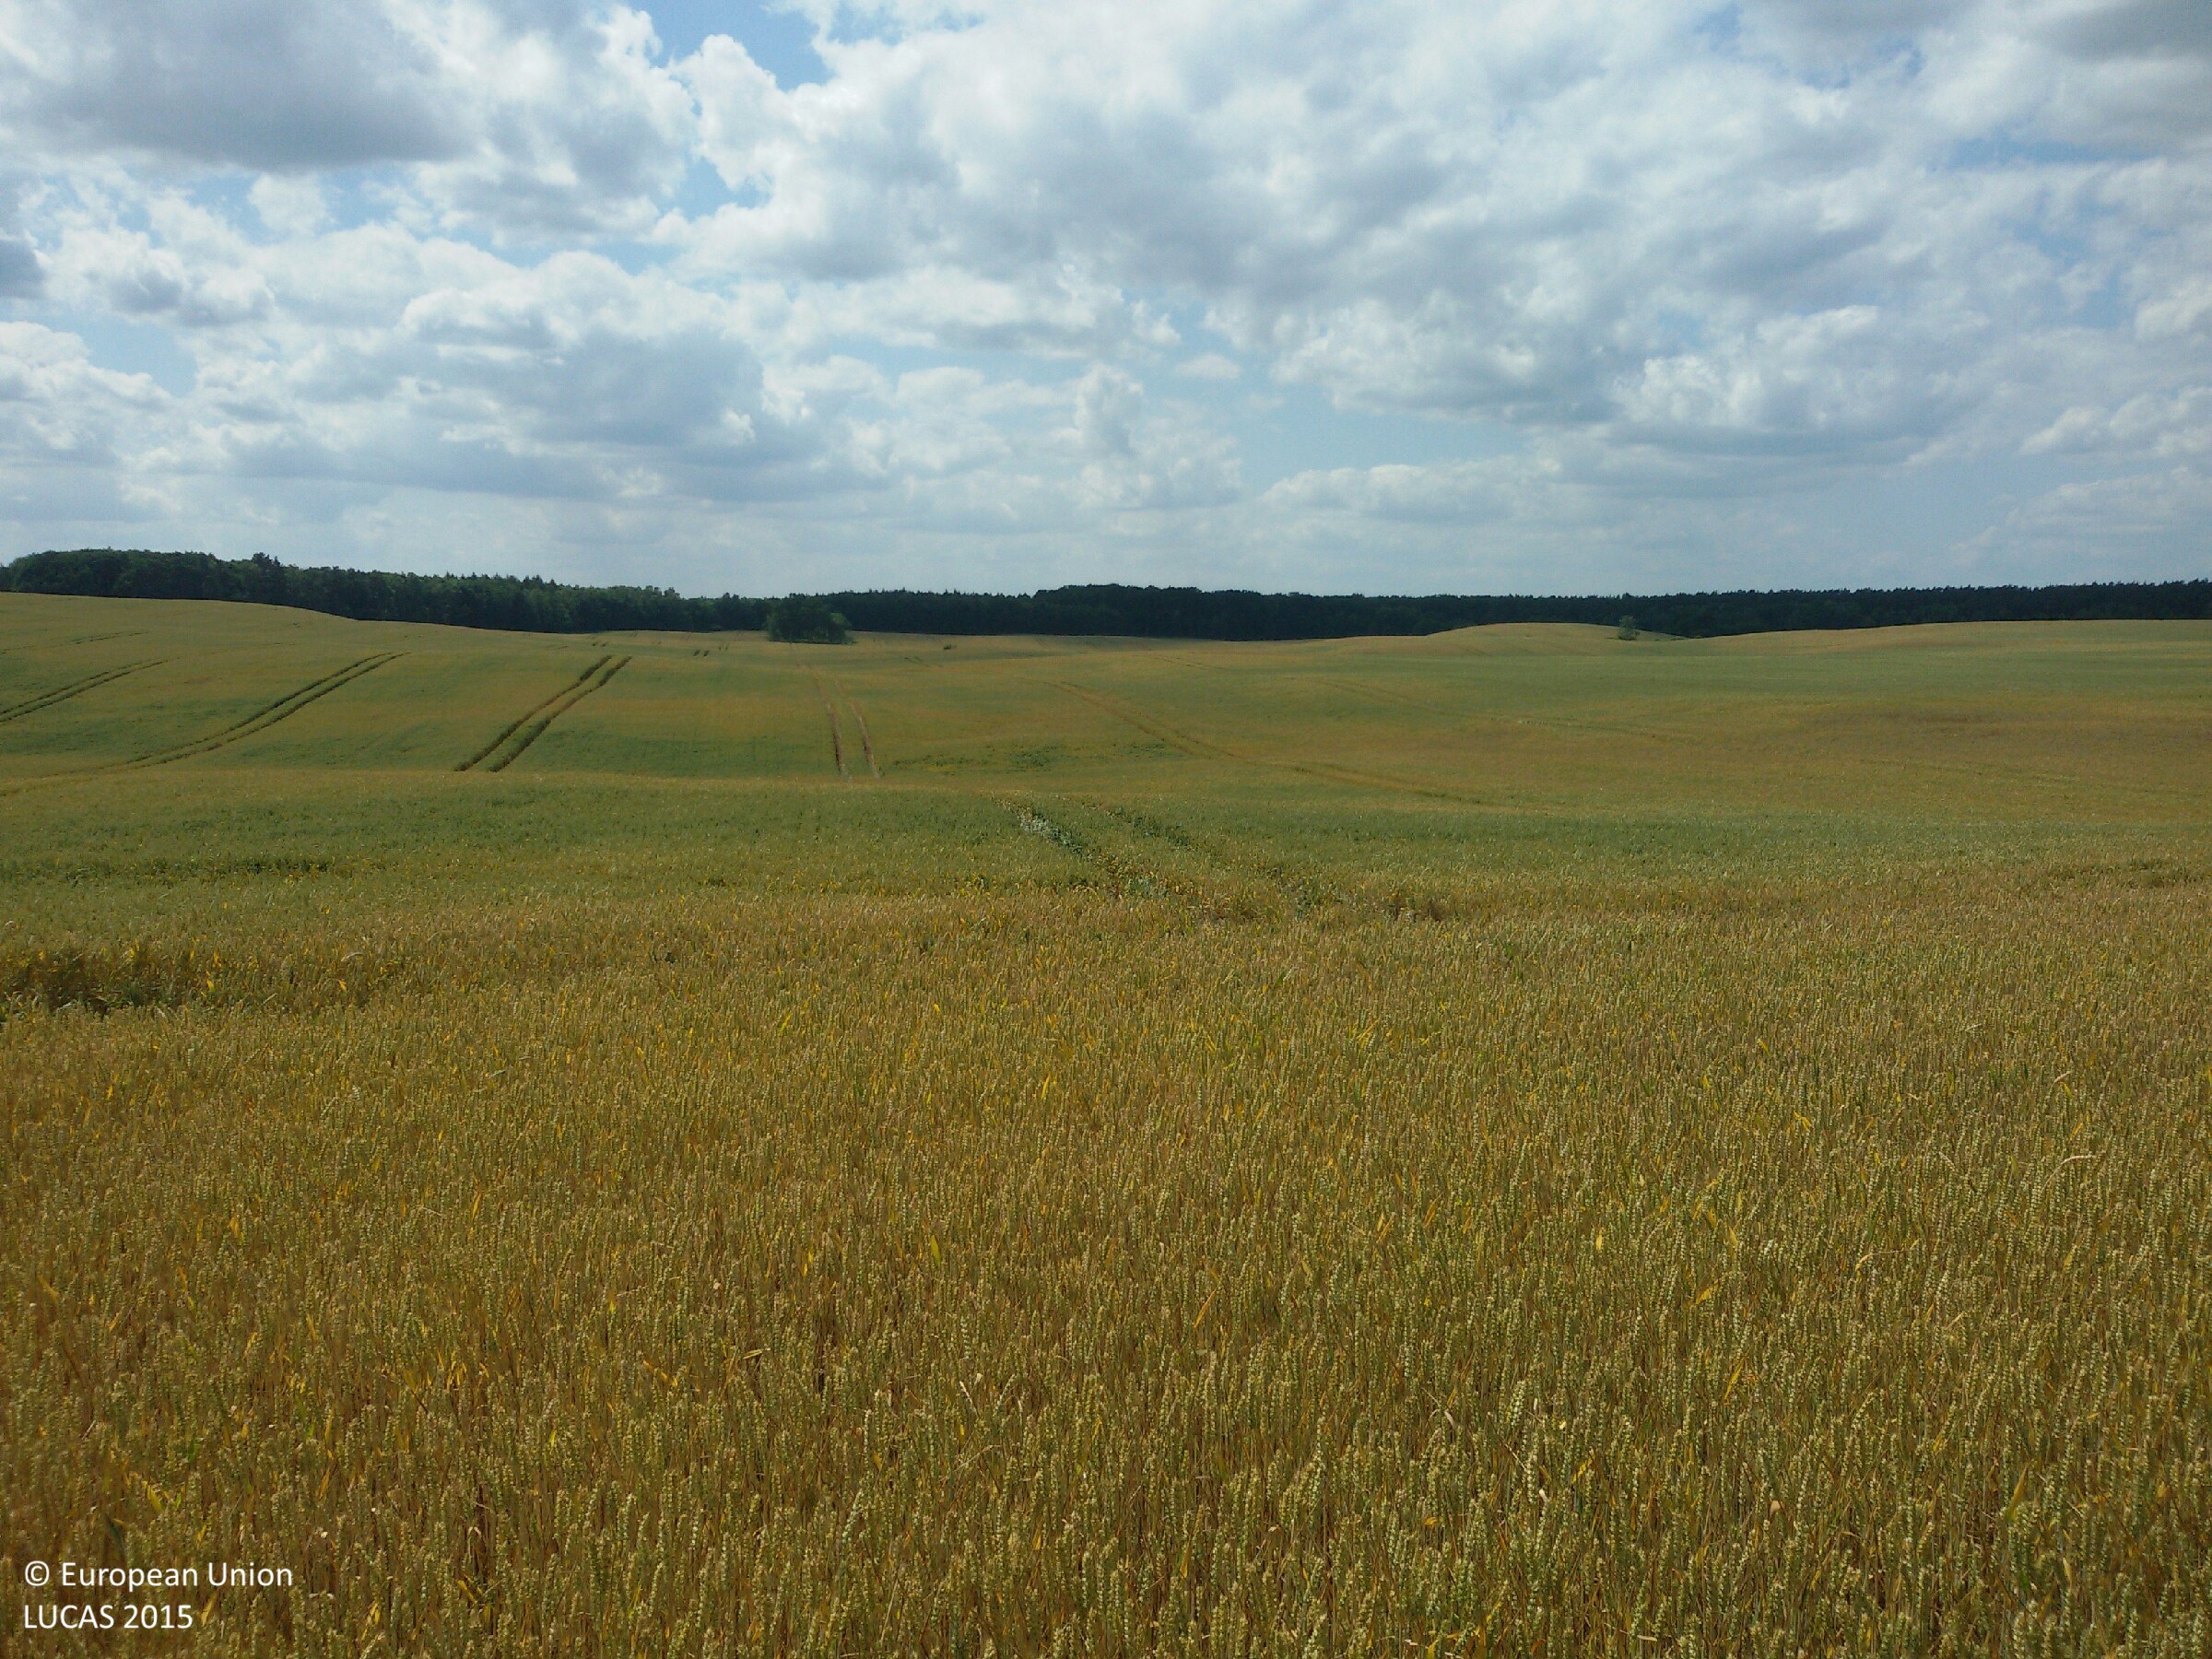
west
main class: Cropland
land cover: Common wheat
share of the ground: > 75 %
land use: Agriculture (excluding fallow land and kitchen gardens)
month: July
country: PL
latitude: 53.0632
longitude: 14.5826
